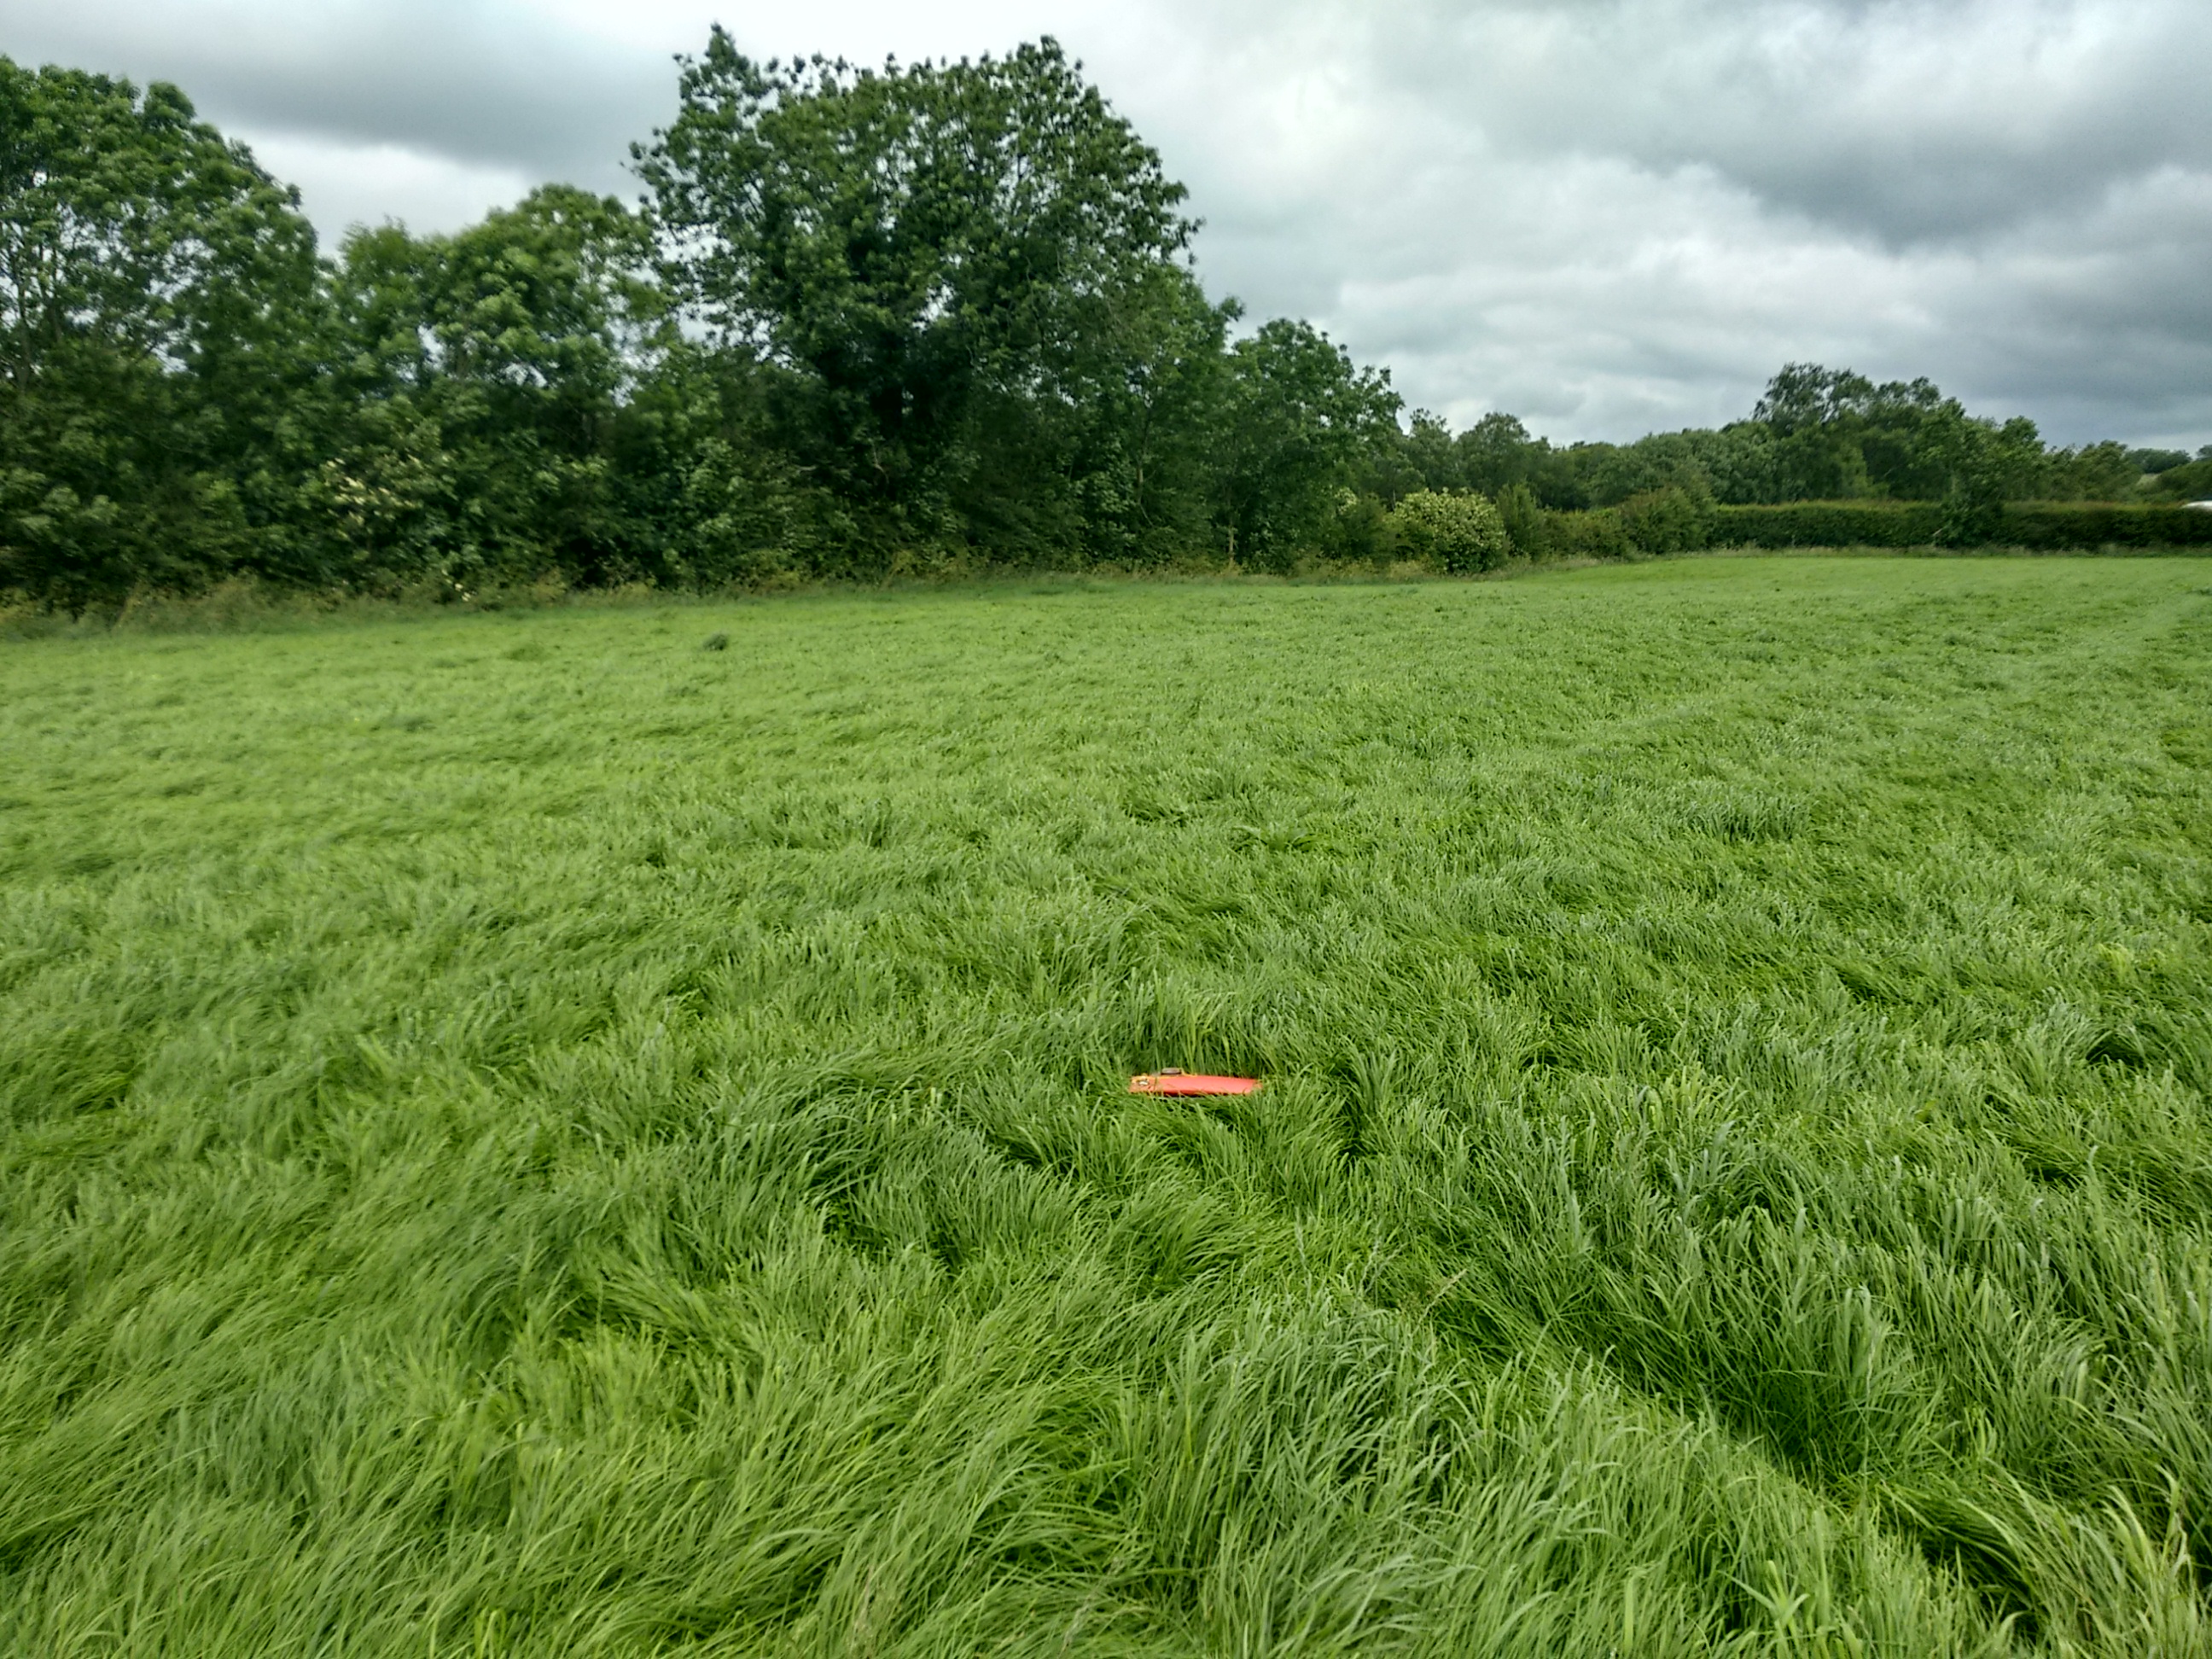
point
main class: Grassland
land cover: Grassland without tree/shrub cover
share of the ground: > 75 %
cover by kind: herbaceous plants 100 %
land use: Agriculture (excluding fallow land and kitchen gardens)
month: July
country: GB
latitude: 54.5604
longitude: -7.1390
